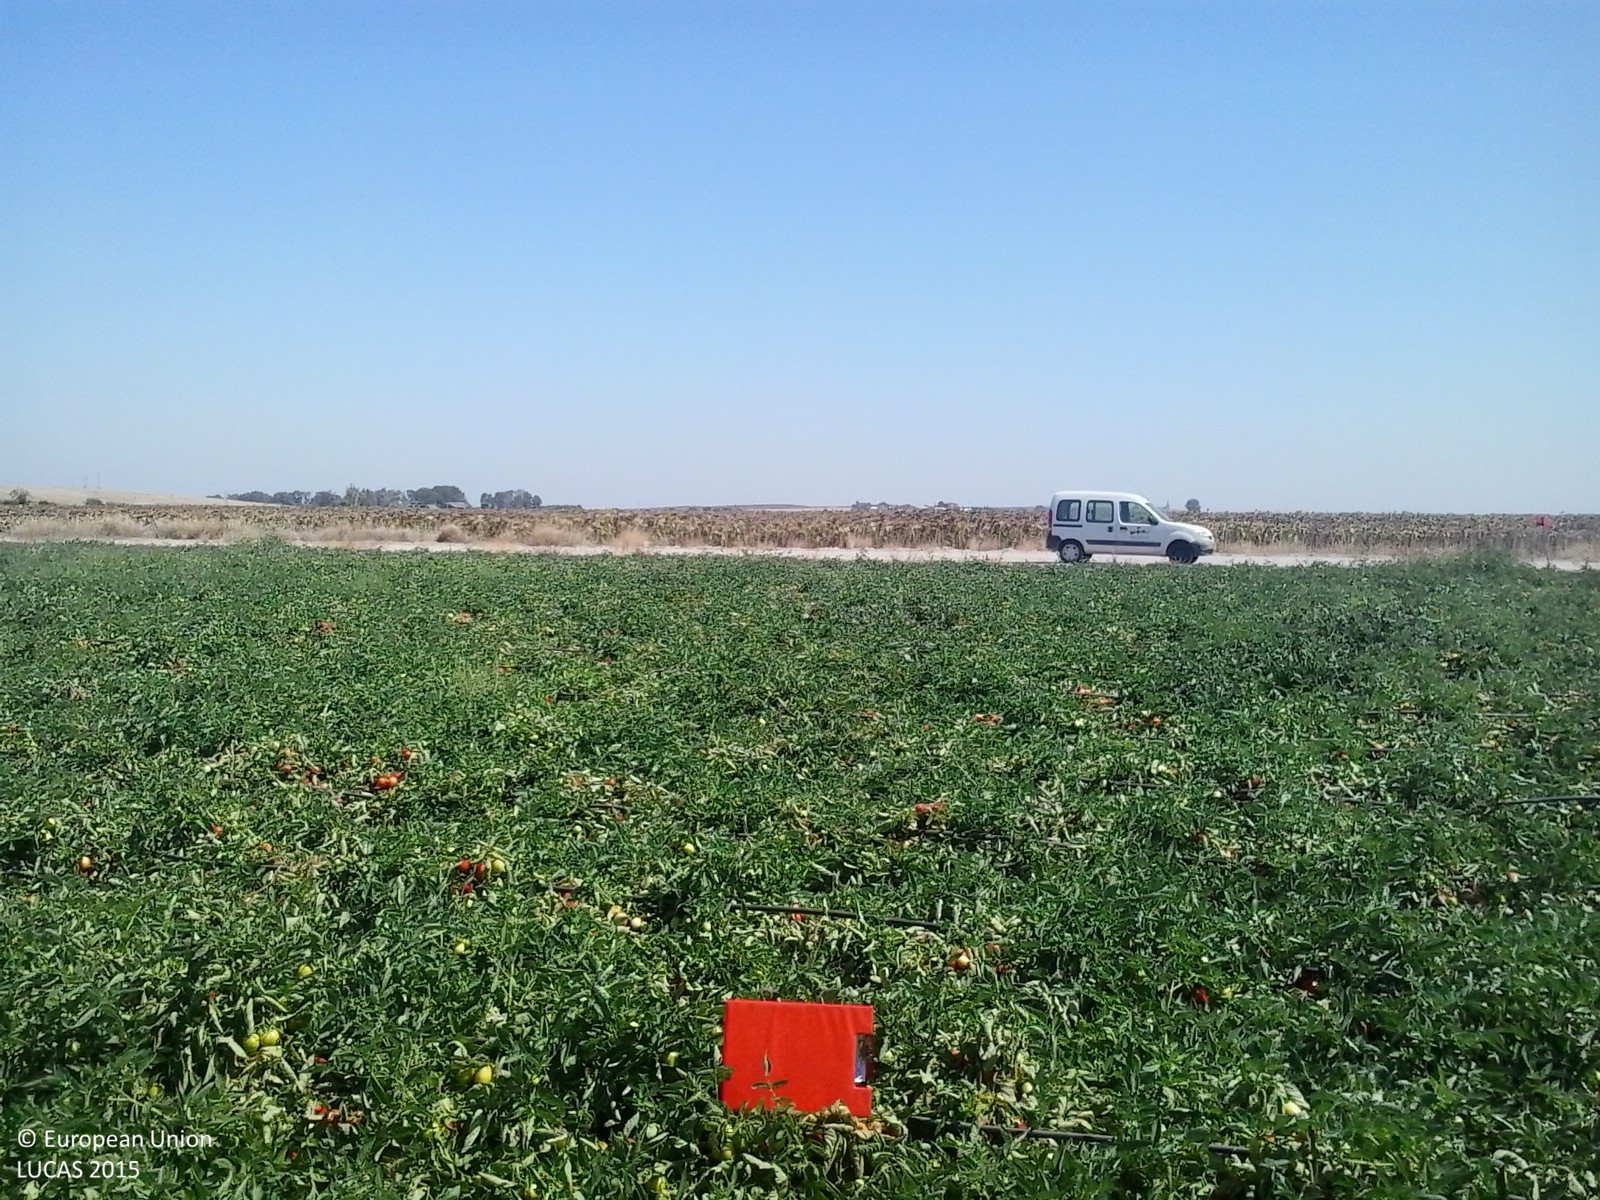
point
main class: Cropland
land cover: Tomatoes
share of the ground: > 75 %
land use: Agriculture (excluding fallow land and kitchen gardens)
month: July
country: ES
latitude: 36.8809
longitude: -6.0019
